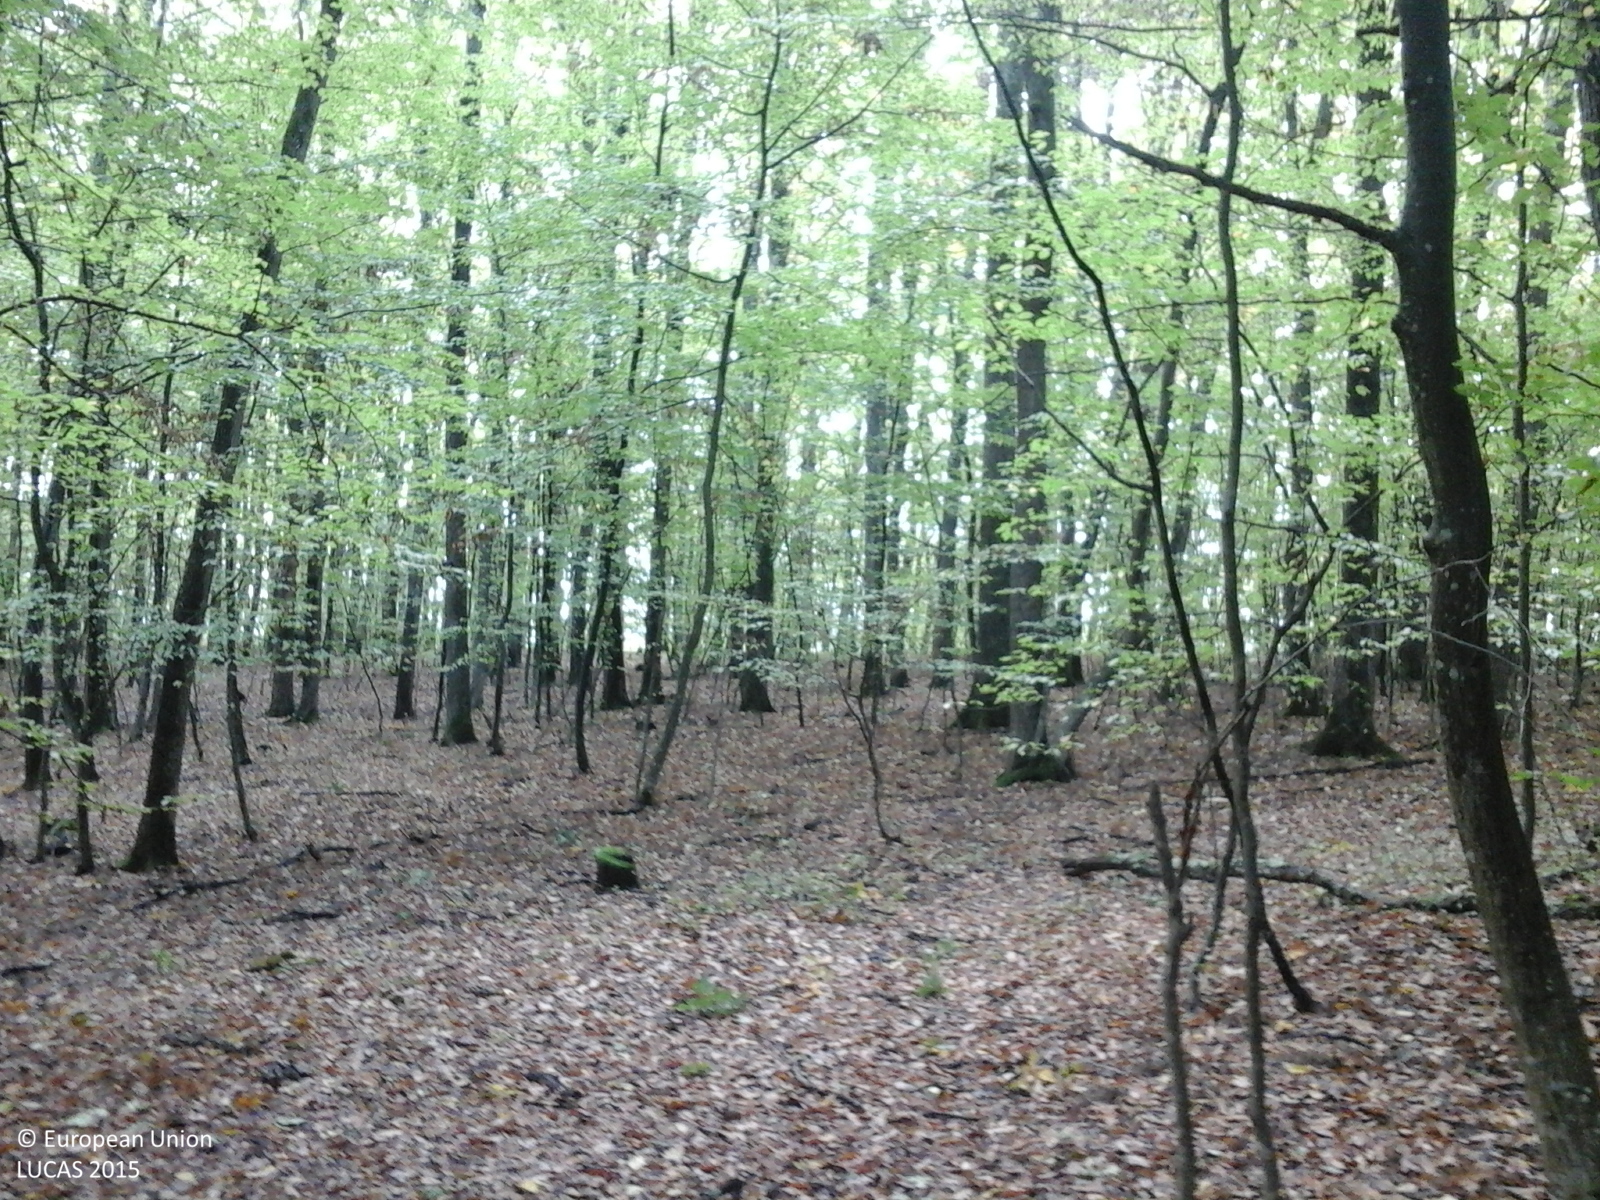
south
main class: Woodland
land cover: Broadleaved woodland
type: beech forest
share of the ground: > 75 %
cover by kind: broadleaved forest trees 100 %
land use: Forestry
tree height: > 5 m
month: October
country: RO
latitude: 45.8798
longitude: 24.6843
